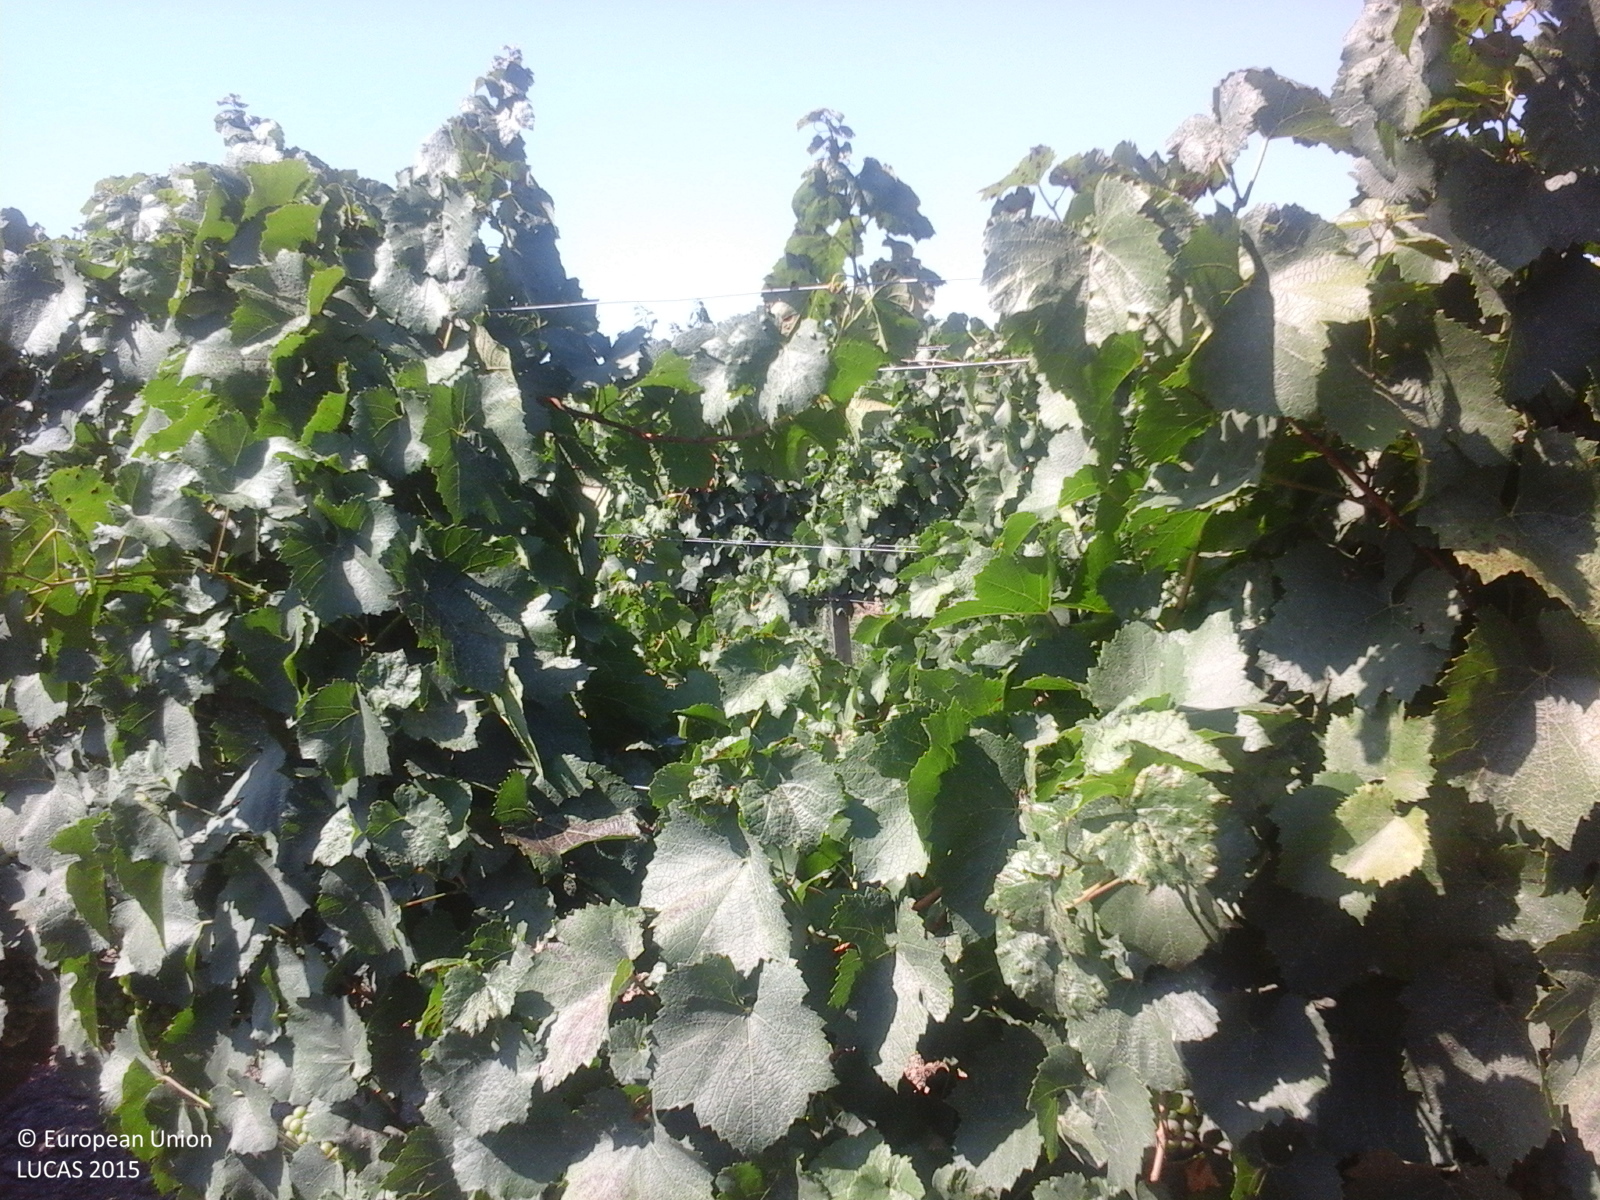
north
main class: Cropland
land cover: Vineyards
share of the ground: 50 - 75 %
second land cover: Other bare soil
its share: > 75 %
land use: Agriculture (excluding fallow land and kitchen gardens)
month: August
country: RO
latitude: 44.5114
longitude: 28.2162
